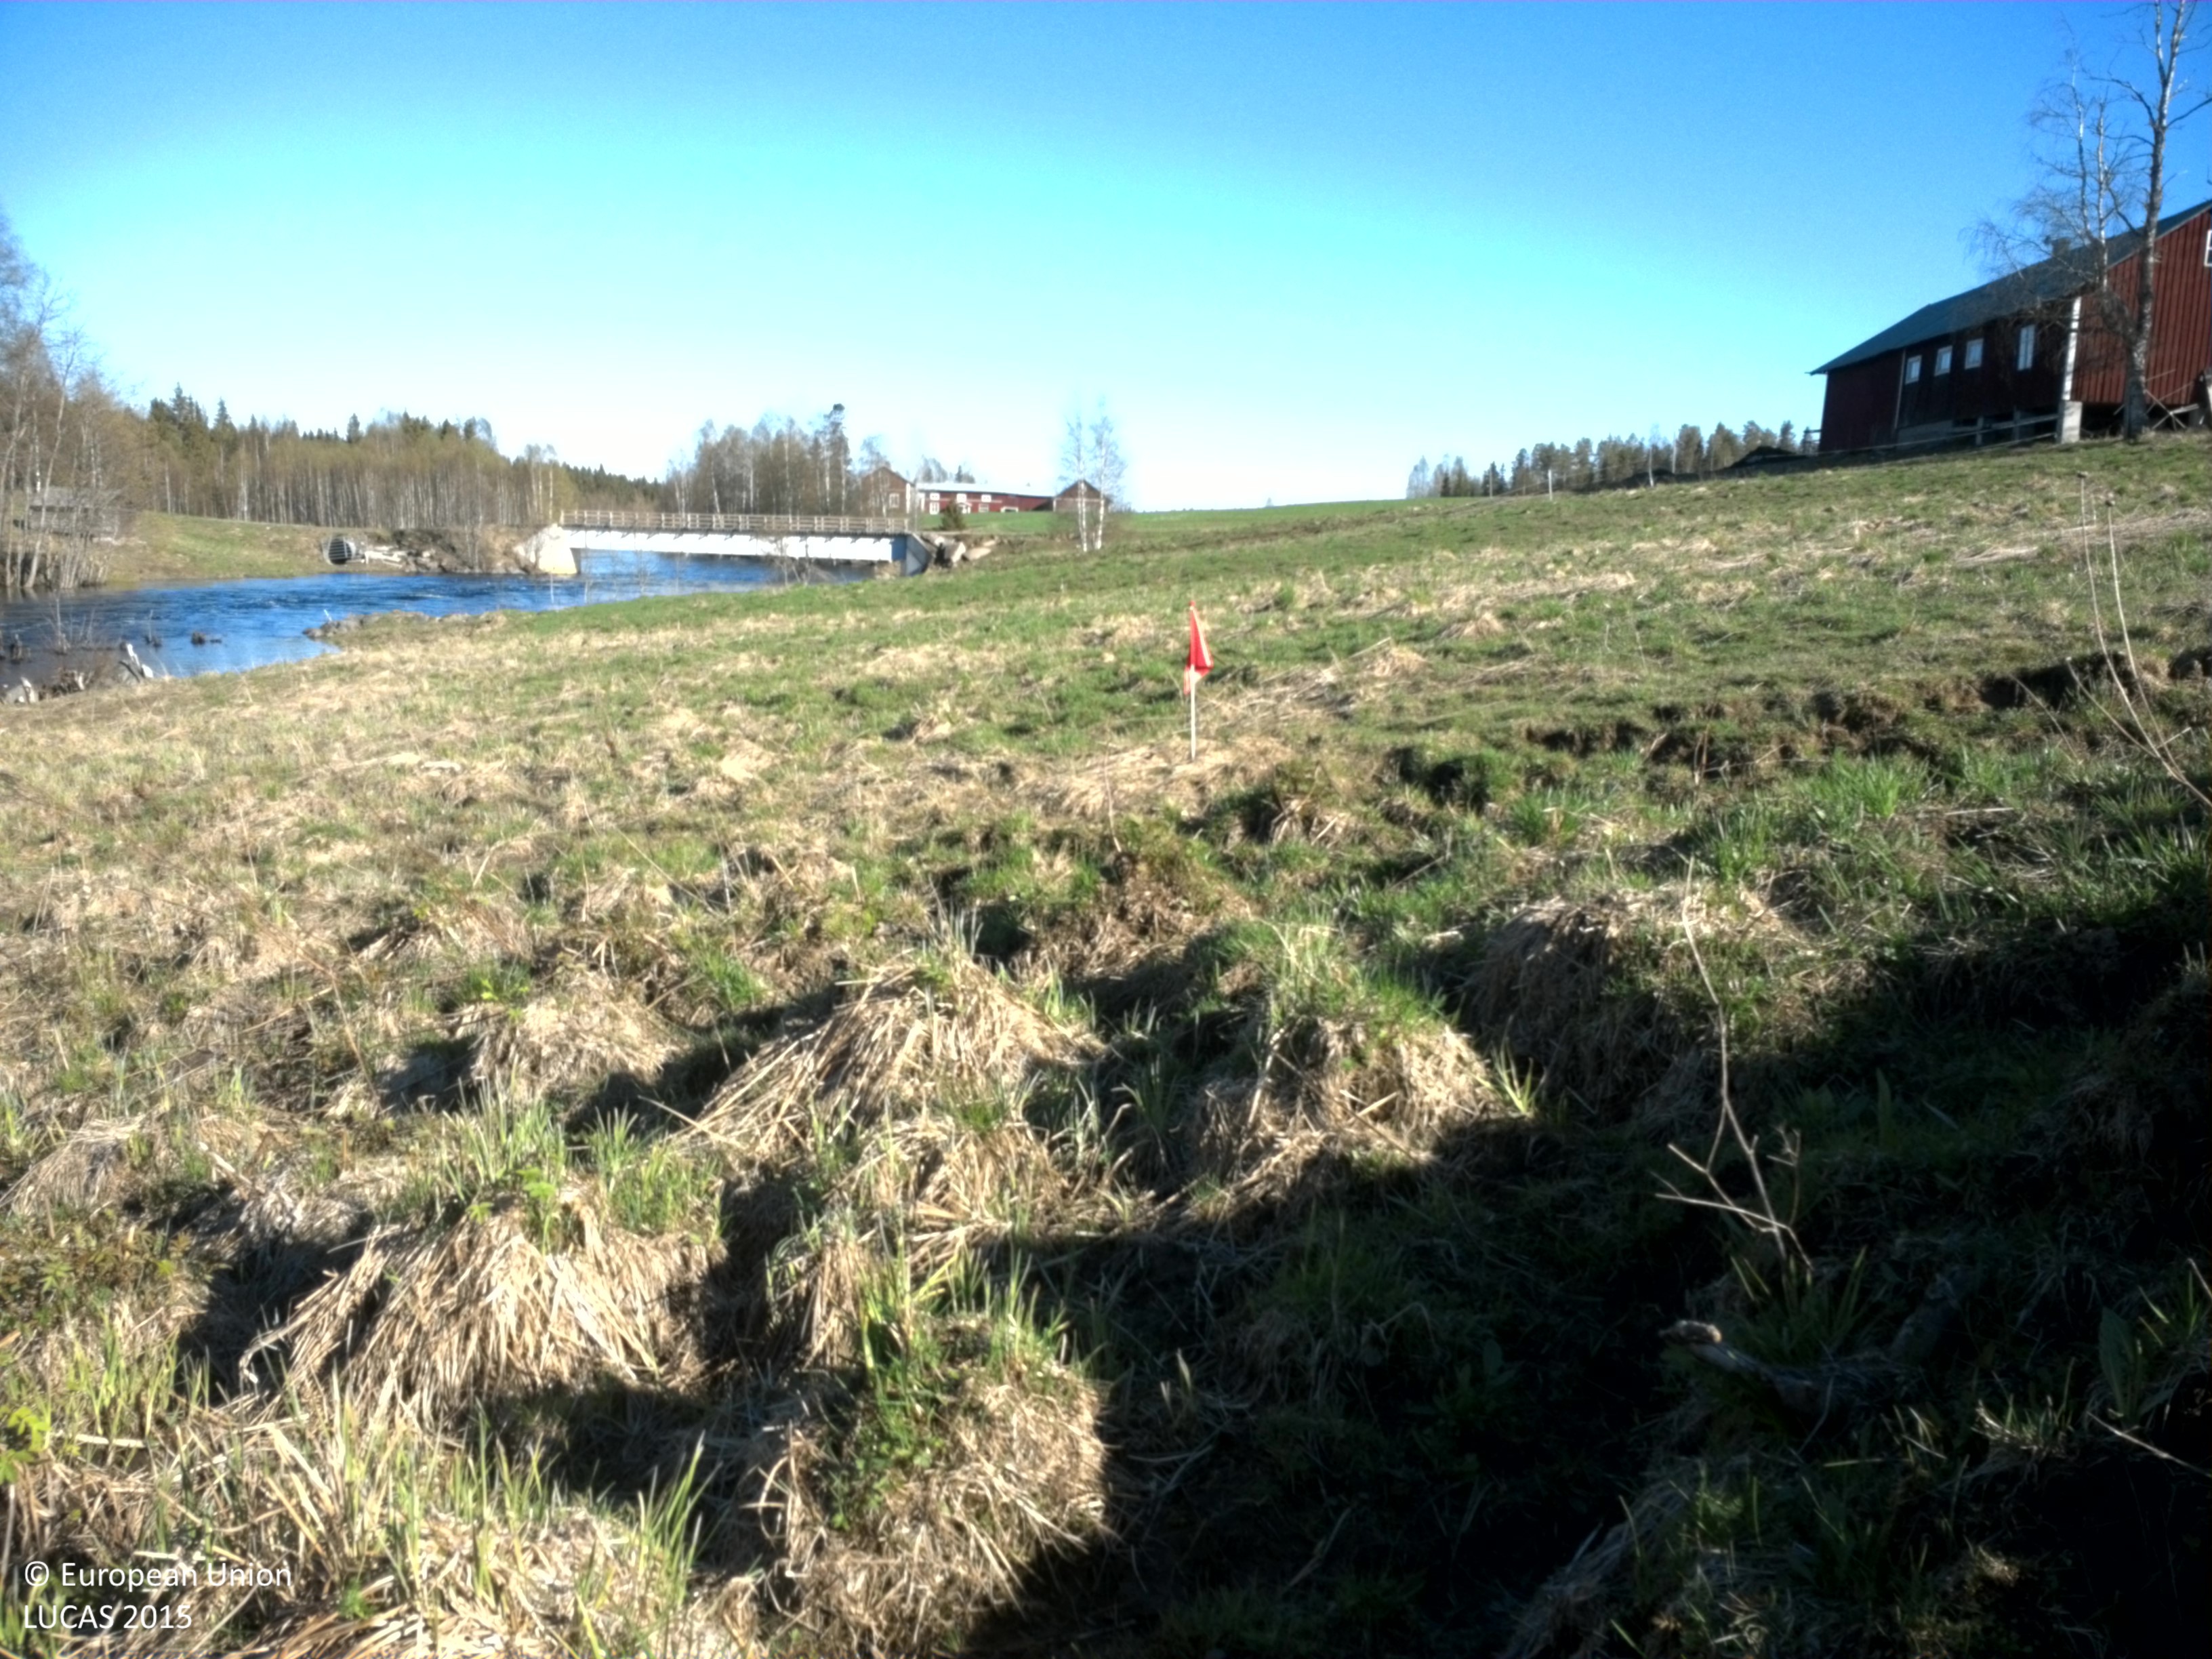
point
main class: Grassland
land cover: Grassland without tree/shrub cover
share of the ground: > 75 %
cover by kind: herbaceous plants 100 %
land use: Agriculture (excluding fallow land and kitchen gardens)
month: May
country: SE
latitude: 66.0918
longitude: 23.3661
